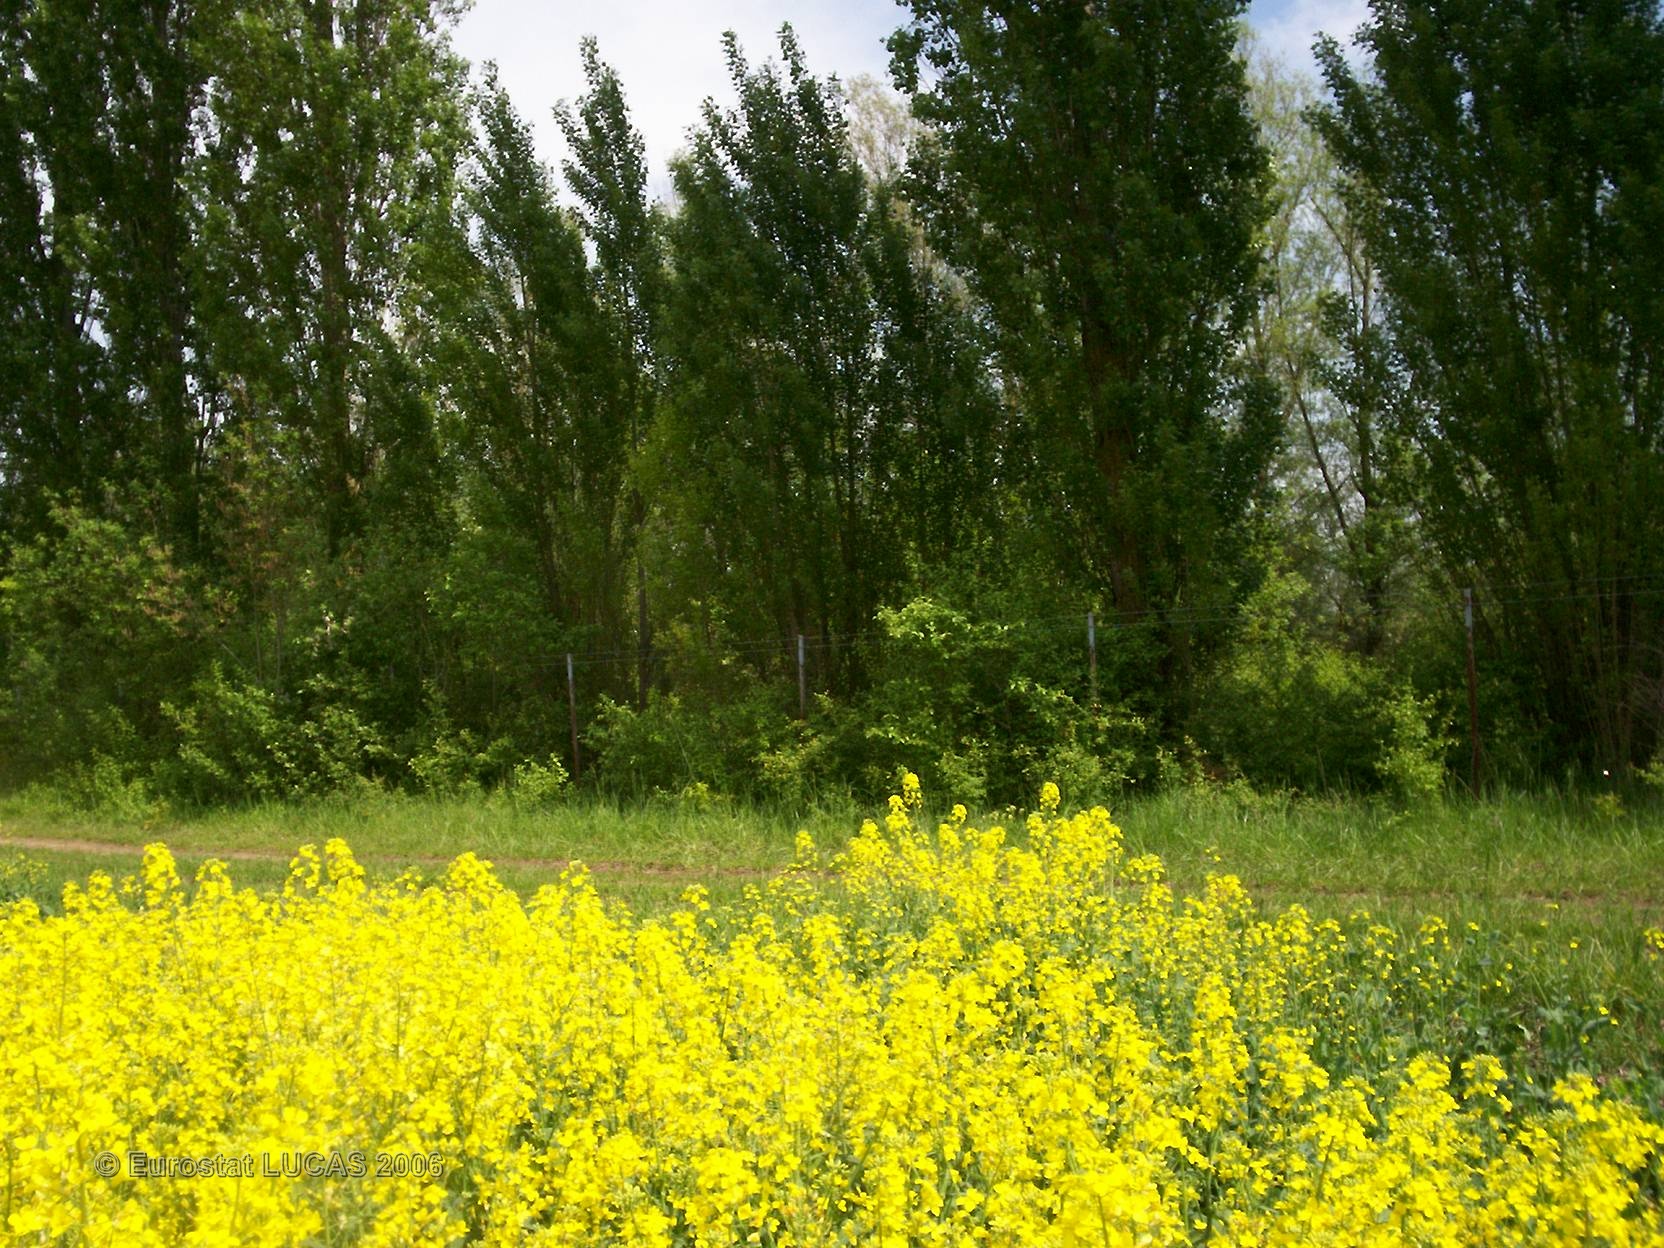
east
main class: Cropland
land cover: Rape and turnip rape
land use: Agriculture (excluding fallow land and kitchen gardens)
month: May
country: FR
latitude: 48.9116
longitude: 4.4158
